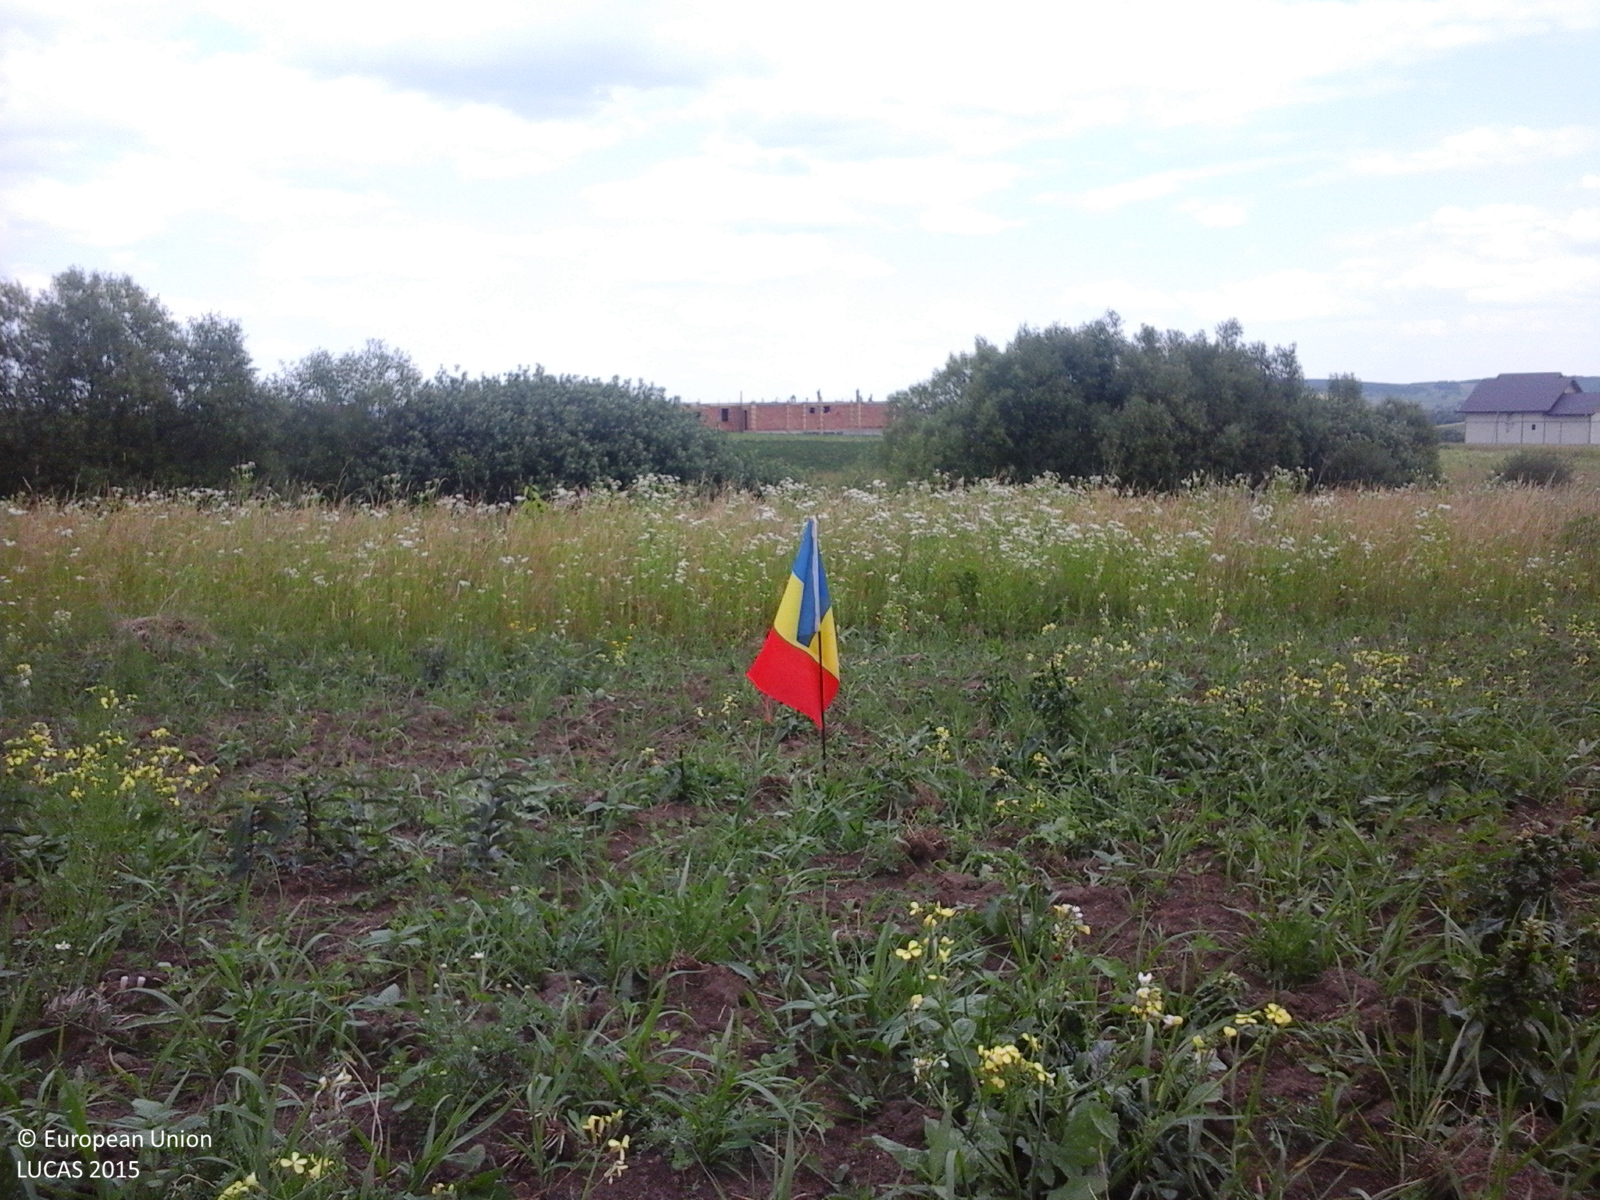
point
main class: Grassland
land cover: Spontaneously vegetated surfaces
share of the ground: 10 - 25 %
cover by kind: herbaceous plants 100 %
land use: Fallow land
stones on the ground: < 10 %
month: June
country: RO
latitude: 47.7476
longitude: 25.9614
